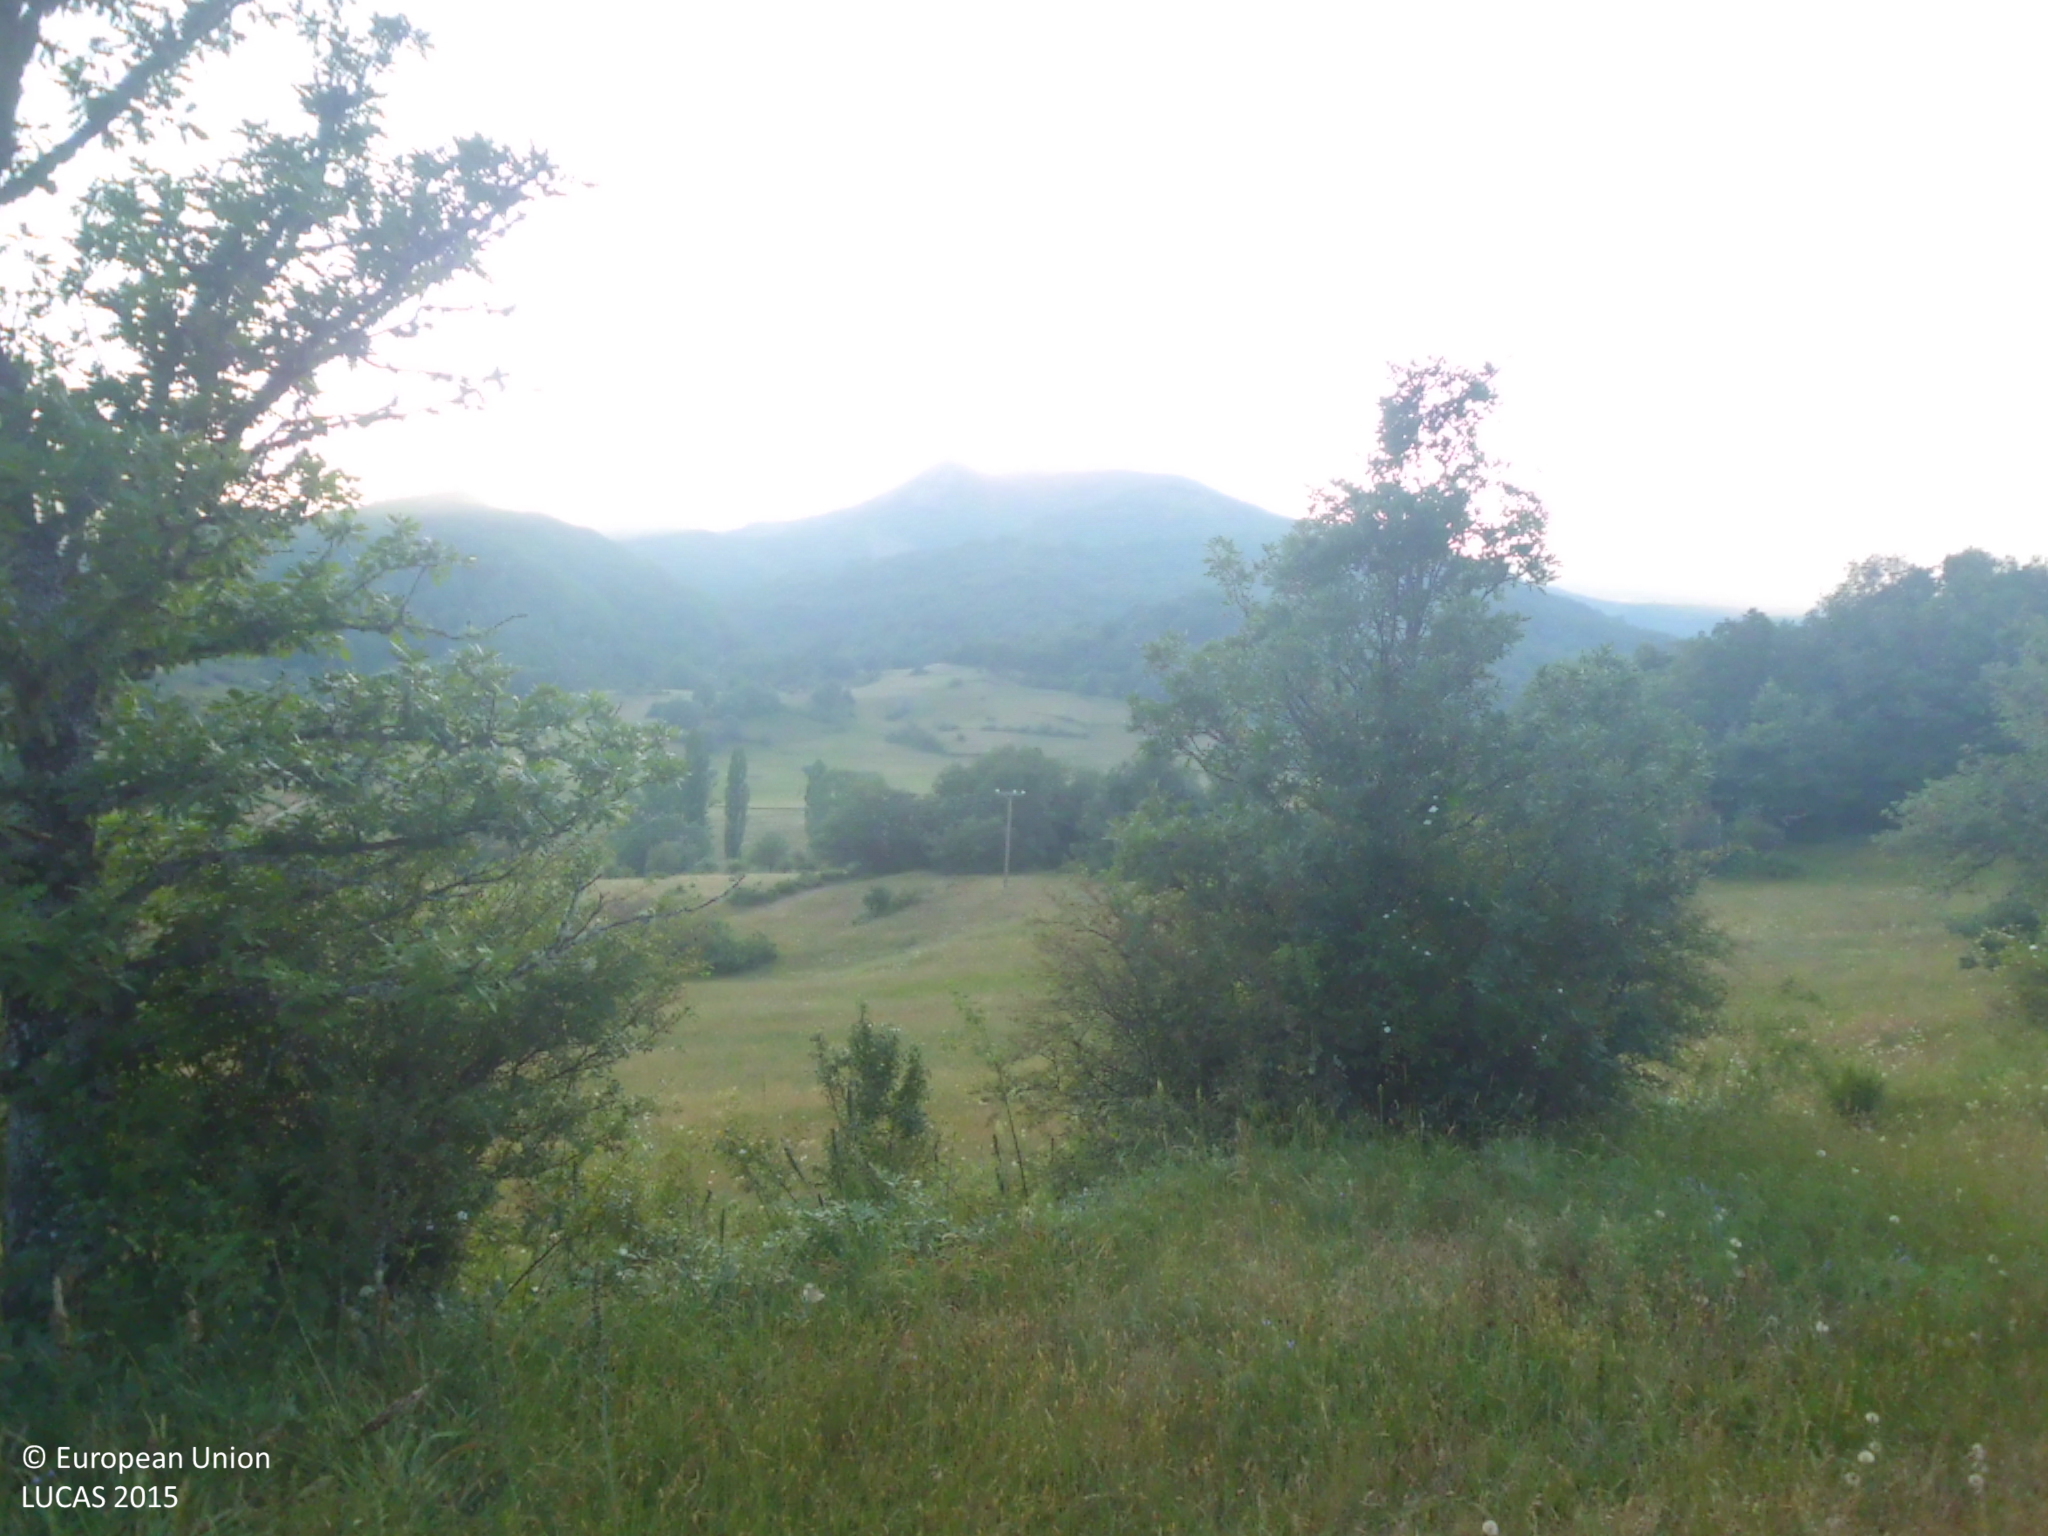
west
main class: Grassland
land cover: Grassland without tree/shrub cover
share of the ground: > 75 %
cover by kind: herbaceous plants 85 %, unconsolidated bare surface 15 %
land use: Agriculture (excluding fallow land and kitchen gardens)
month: June
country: ES
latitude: 42.8878
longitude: -4.9904
